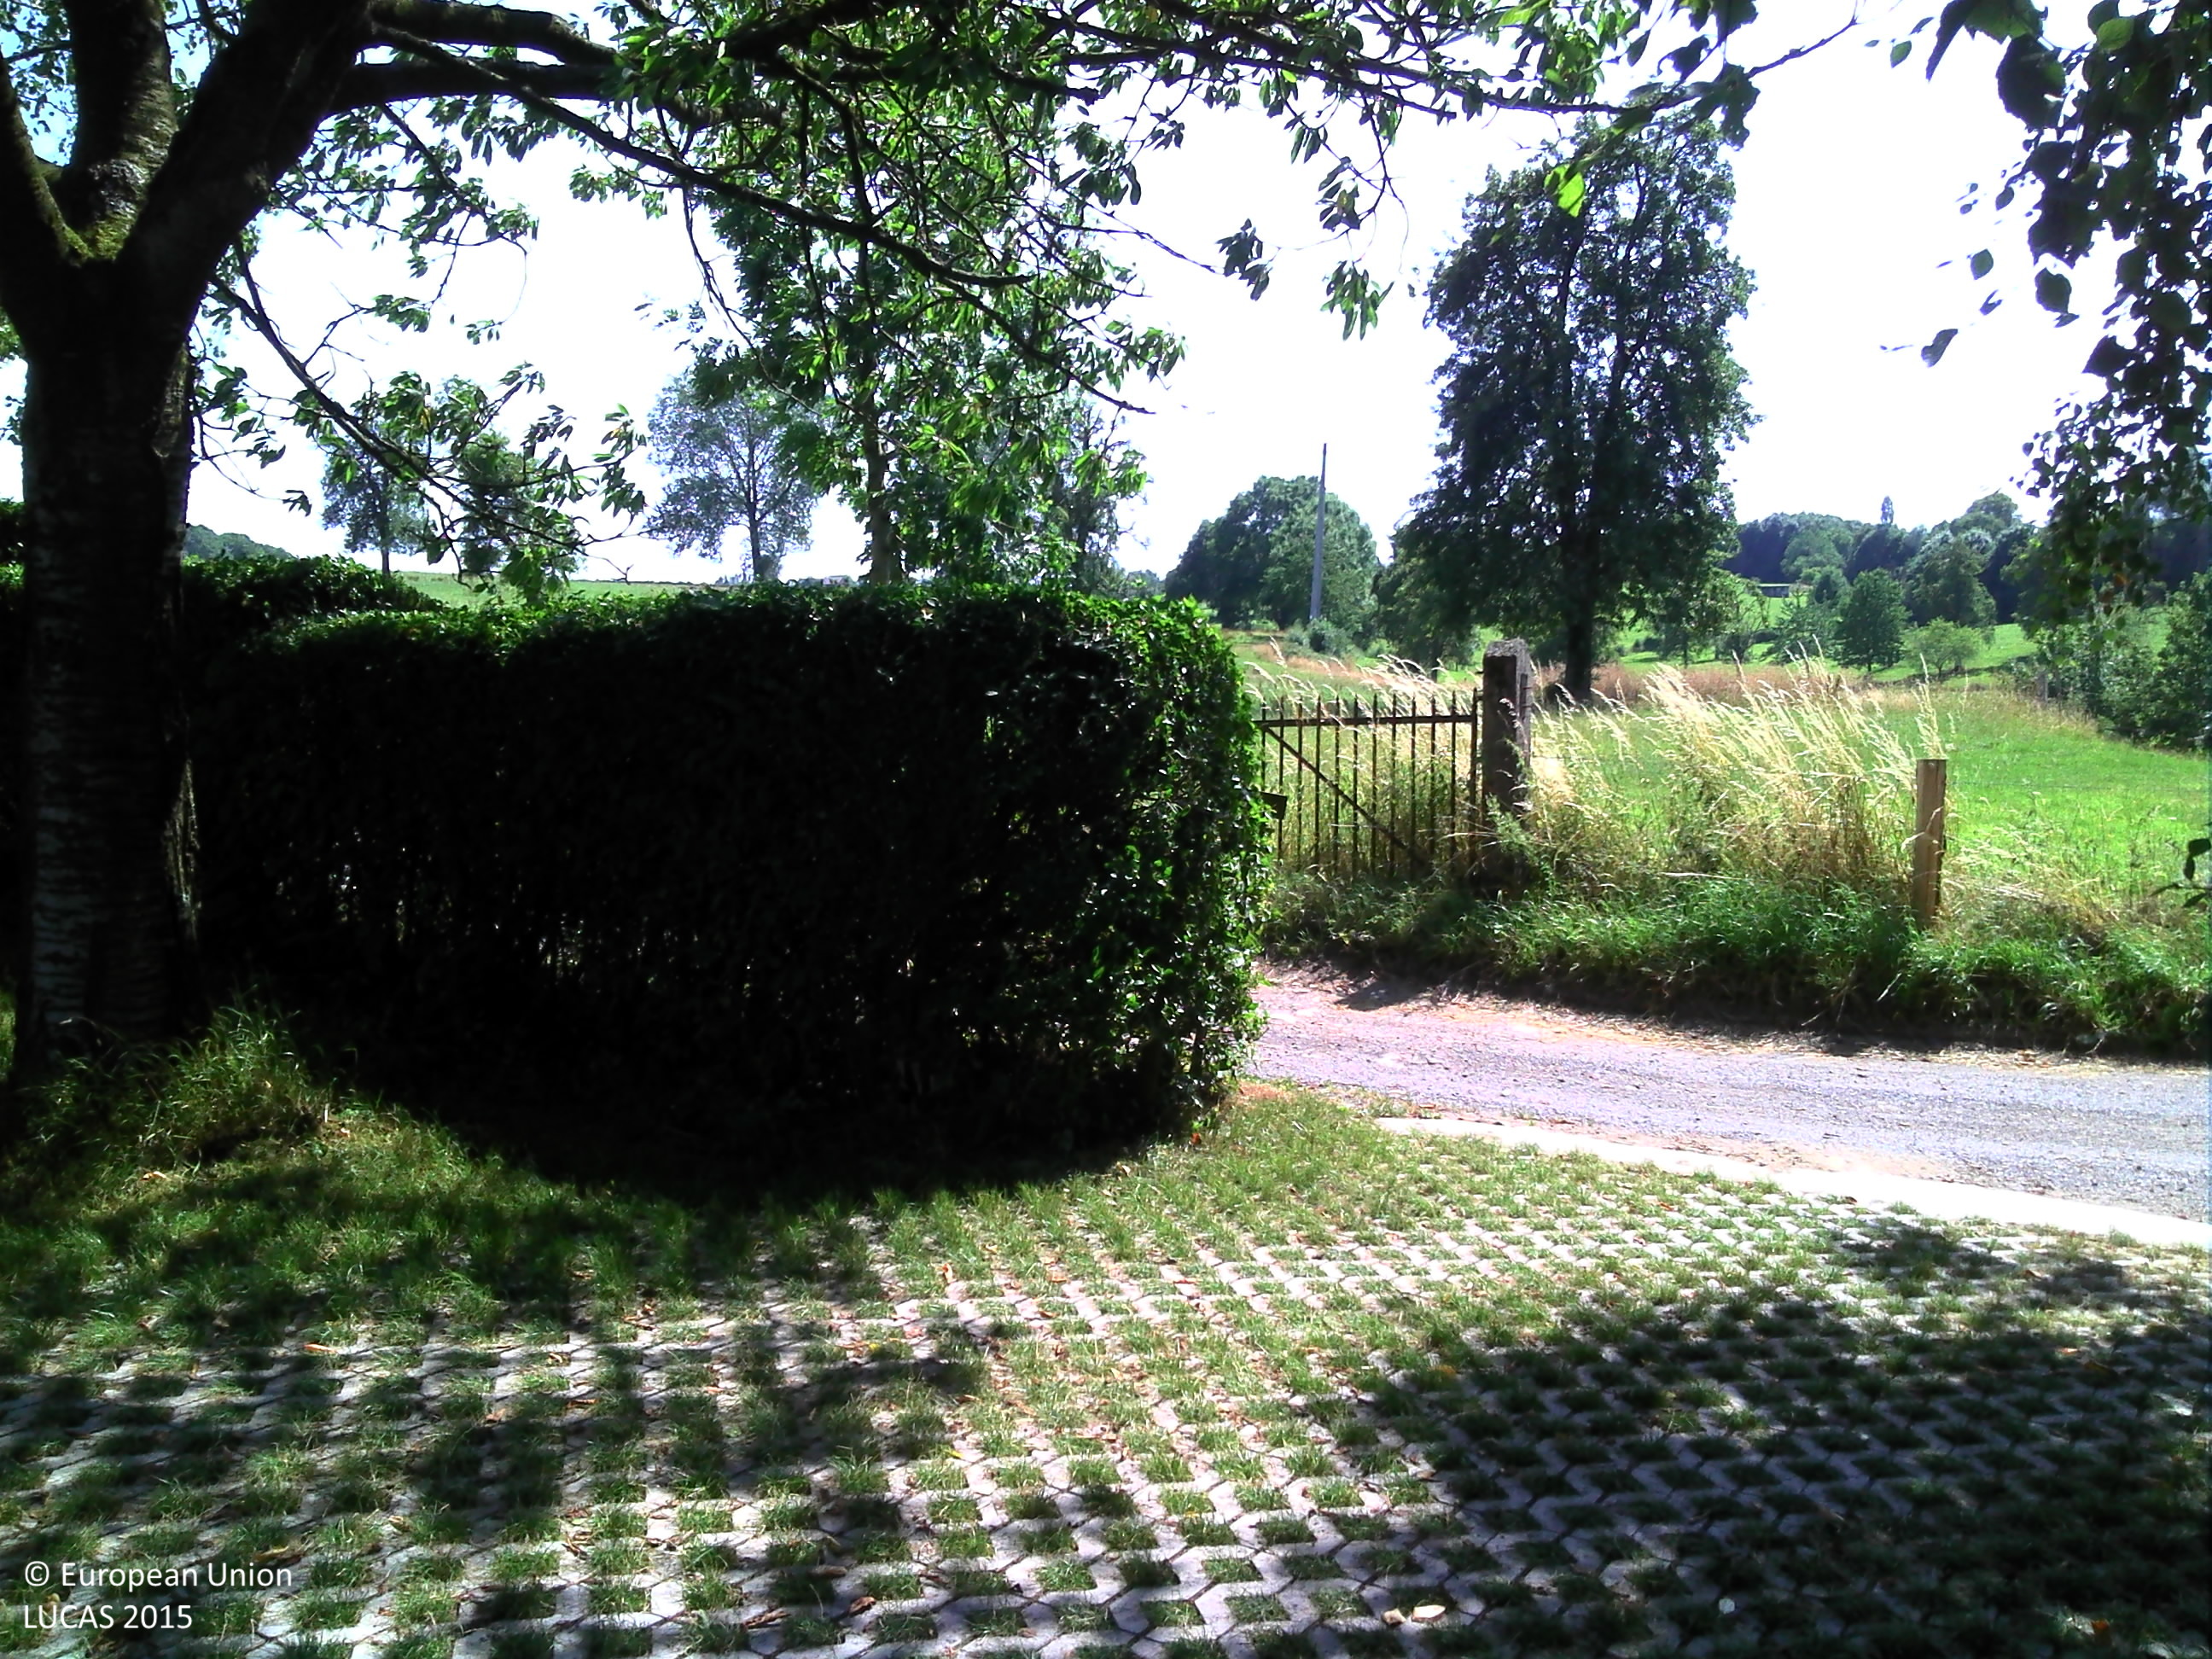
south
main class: Grassland
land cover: Grassland with sparse tree/shrub cover
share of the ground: > 75 %
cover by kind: herbaceous plants 95 %, broadleaved forest trees 5 %
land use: Residential
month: July
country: BE
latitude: 50.6428
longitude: 5.6855
